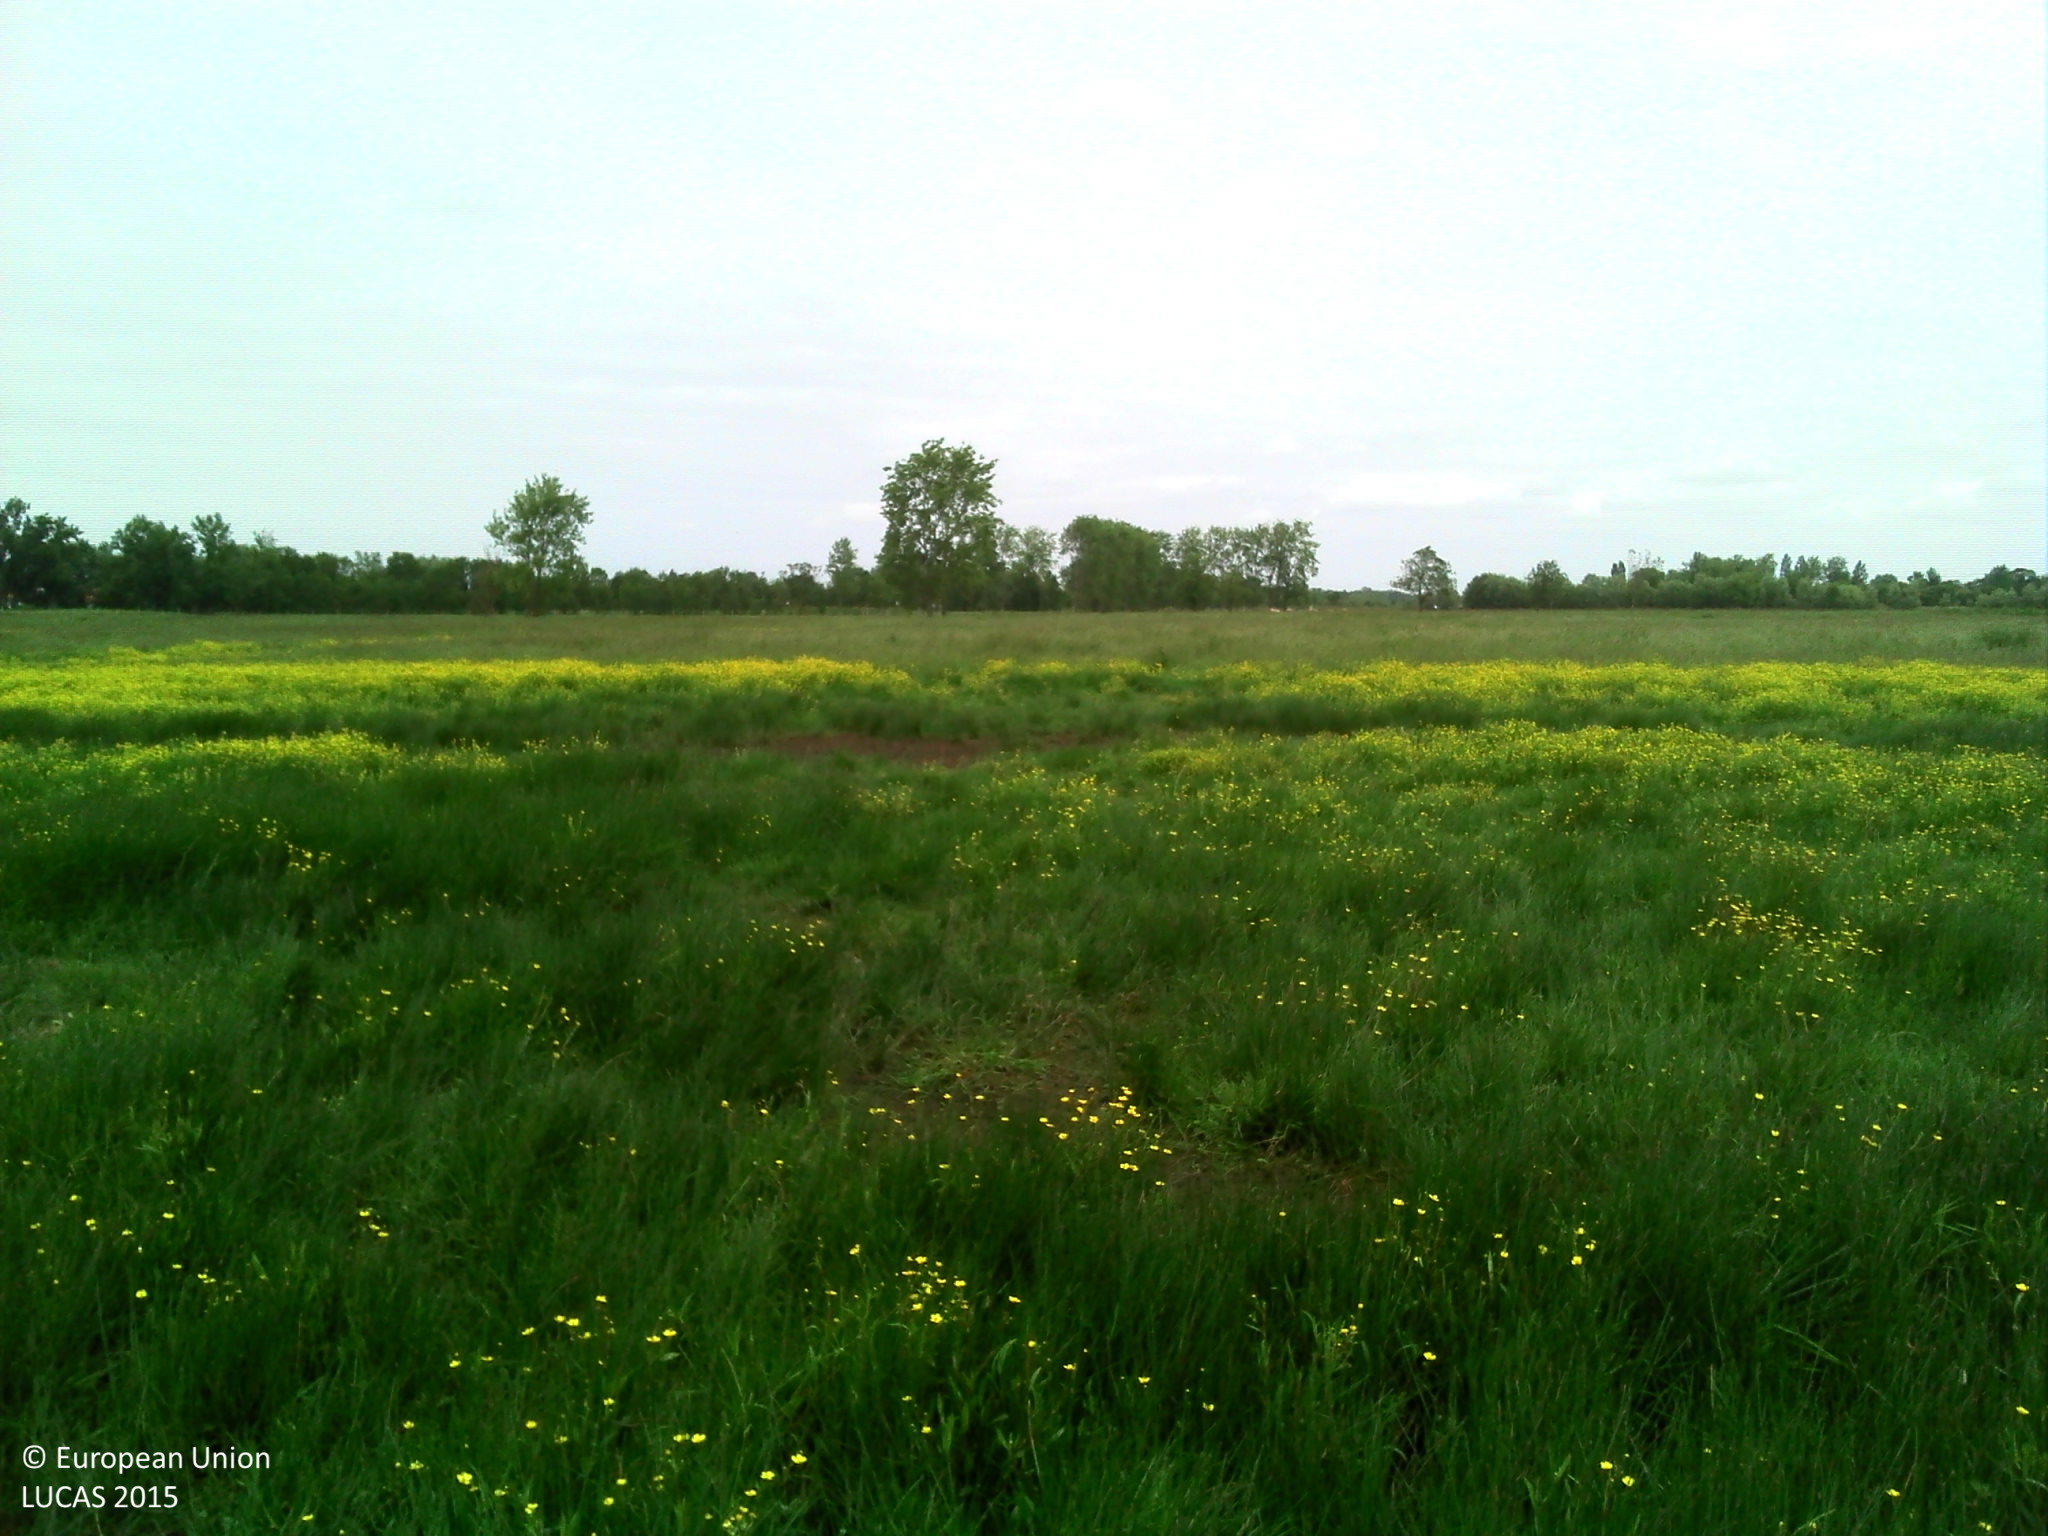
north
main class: Grassland
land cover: Grassland without tree/shrub cover
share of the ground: > 75 %
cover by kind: herbaceous plants 100 %
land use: Agriculture (excluding fallow land and kitchen gardens)
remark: Temporary flooded
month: June
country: FR
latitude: 46.8444
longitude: -1.9390
